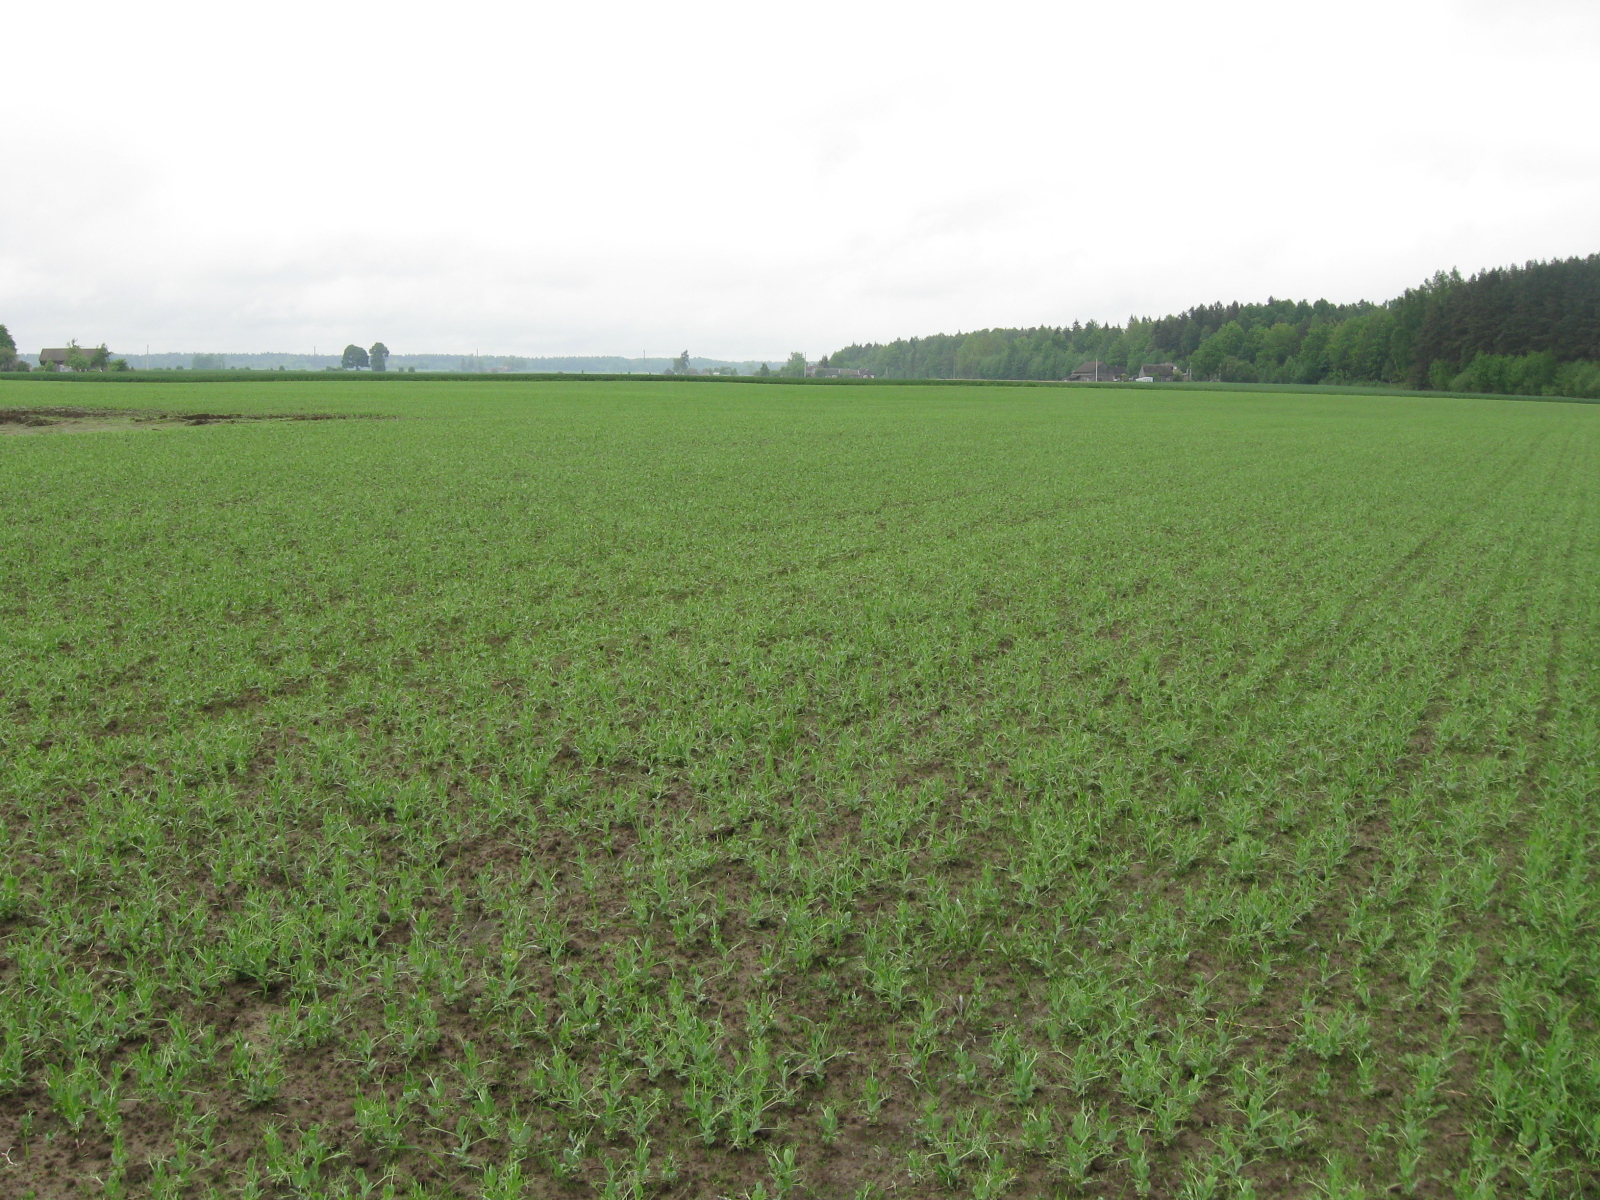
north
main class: Cropland
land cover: Dry pulses
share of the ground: > 75 %
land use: Agriculture (excluding fallow land and kitchen gardens)
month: May
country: LT
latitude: 54.9636
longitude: 22.7653
